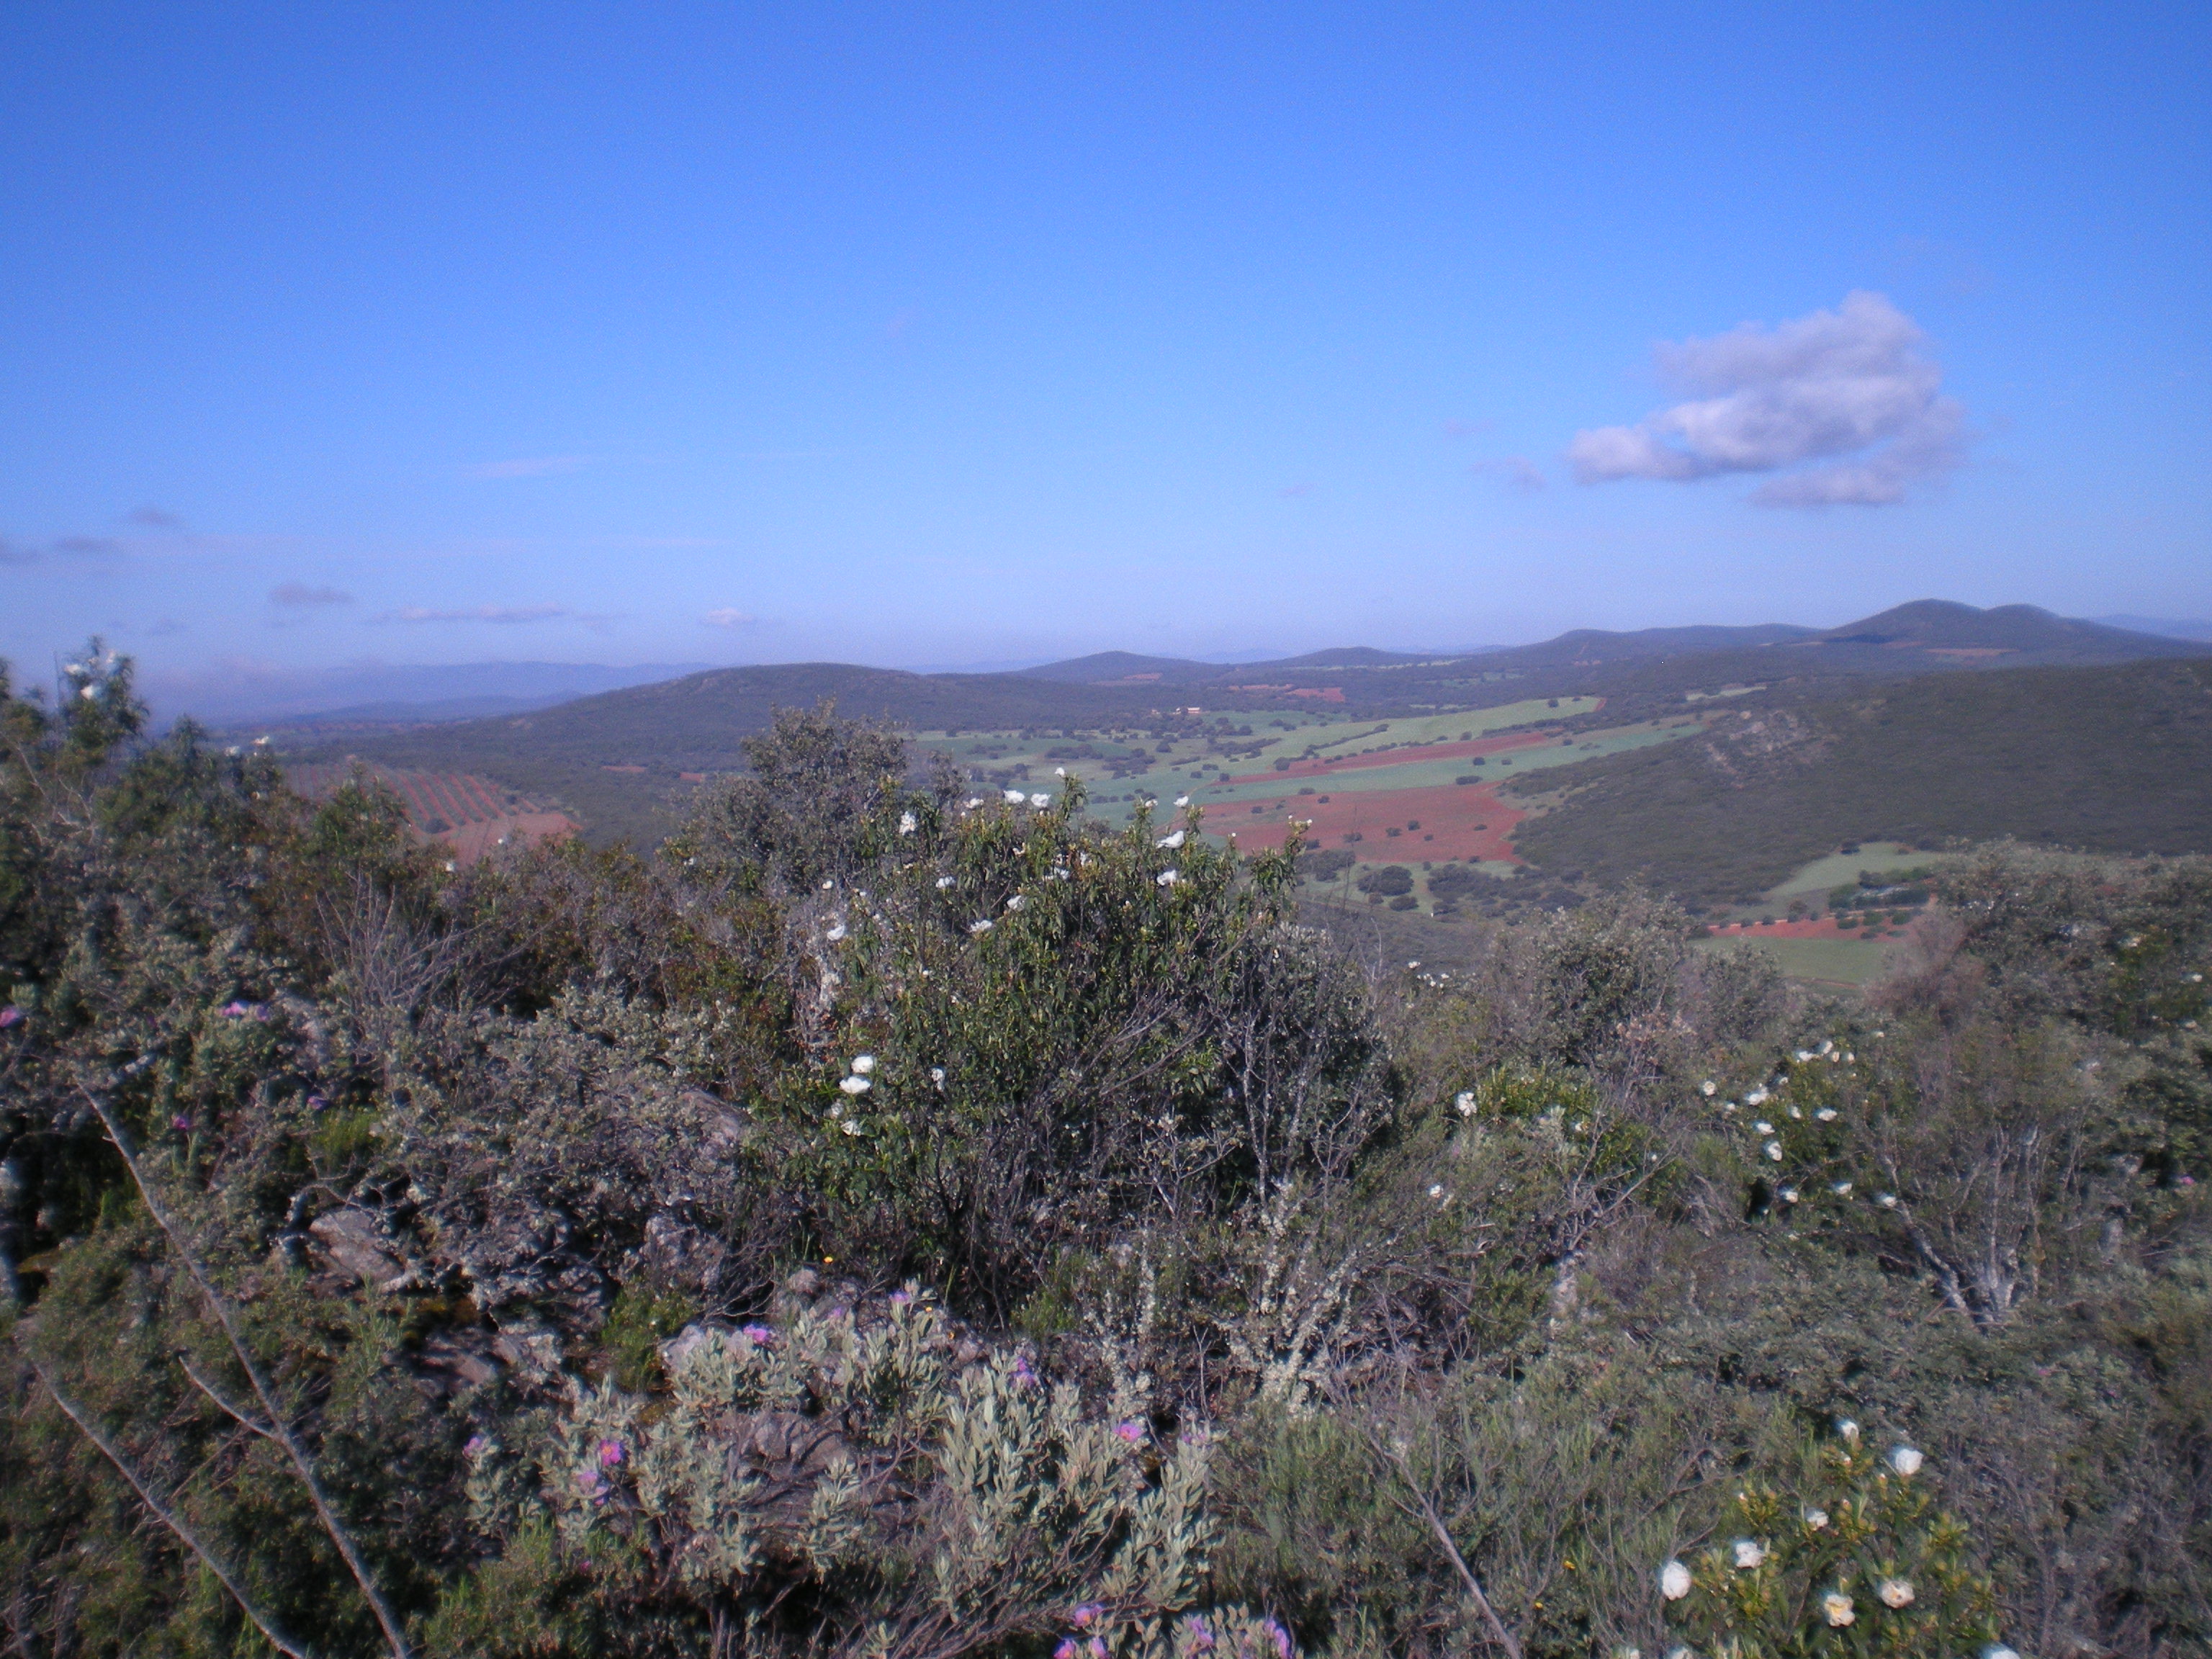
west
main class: Shrubland
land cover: Shrubland with sparse tree cover
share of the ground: > 75 %
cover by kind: shrubs 80 %, consolidated bare surface 15 %, broadleaved forest trees 5 %
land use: Other primary production
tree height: < 5 m
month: April
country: ES
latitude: 38.5651
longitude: -3.3321
